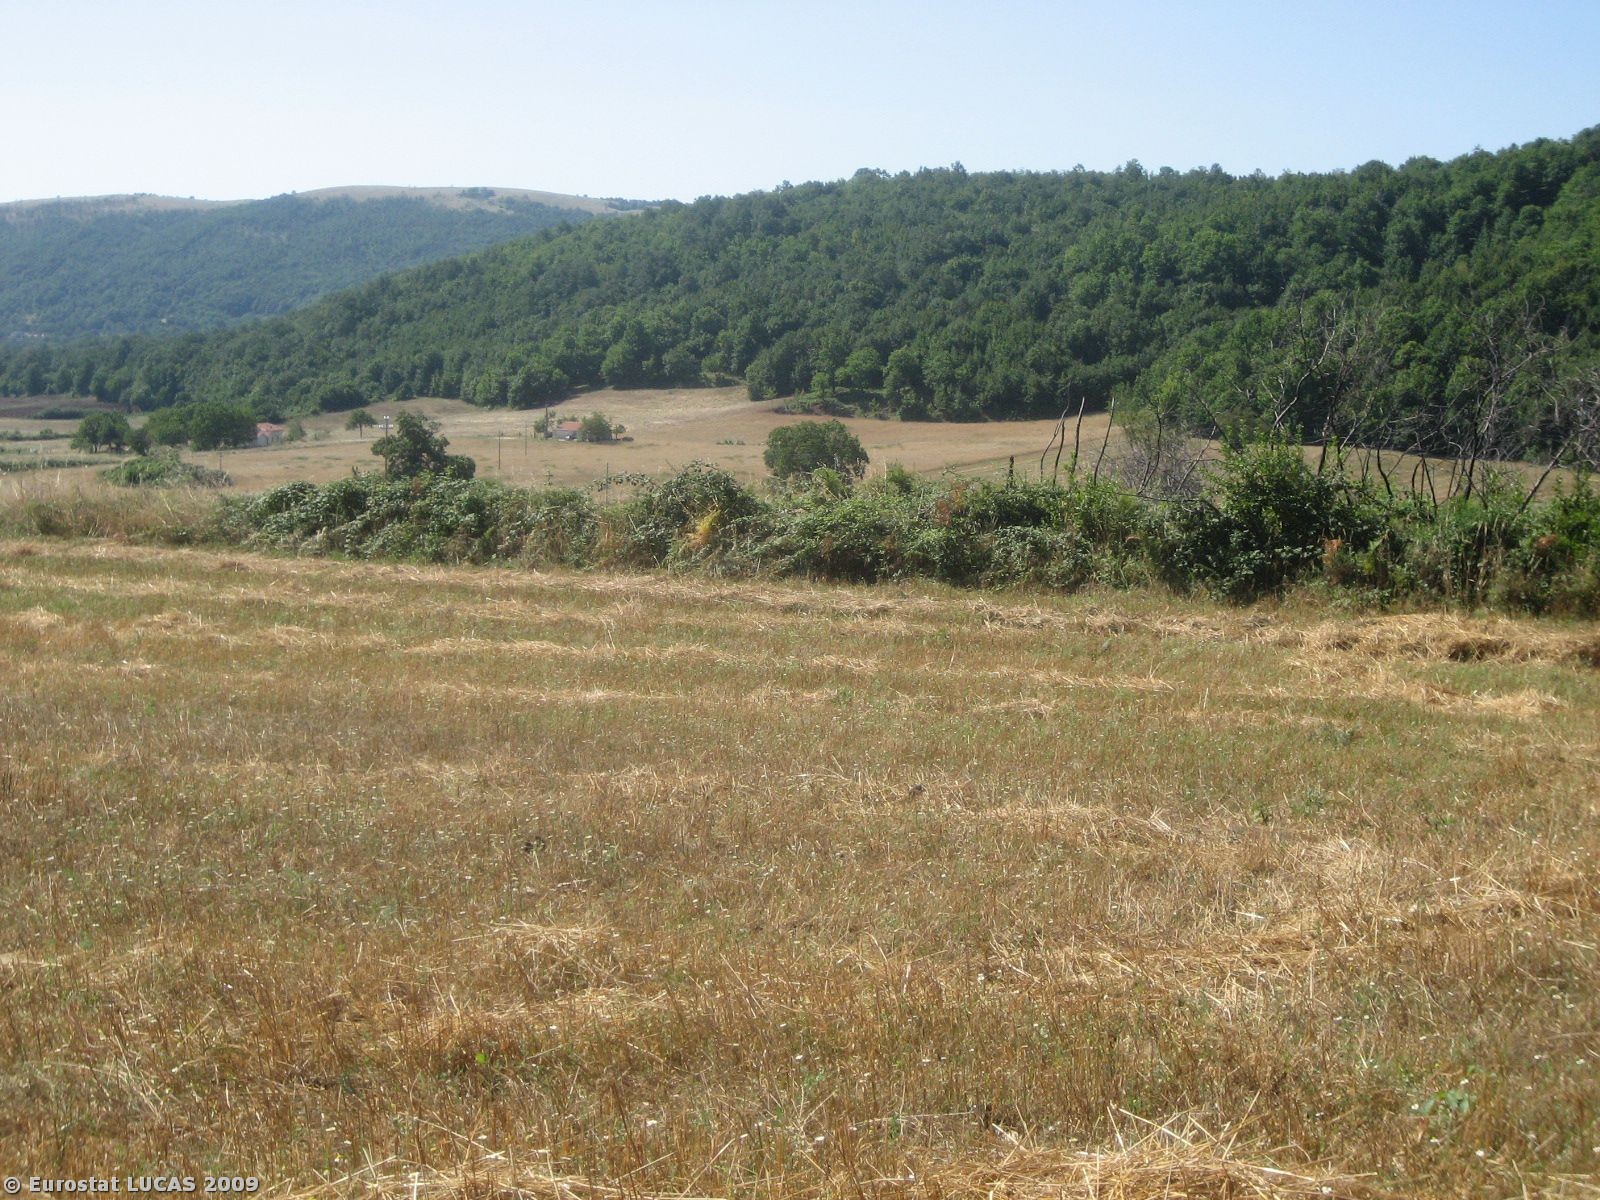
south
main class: Grassland
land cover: Grassland with sparse tree/shrub cover
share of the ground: > 75 %
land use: Agriculture (excluding fallow land and kitchen gardens)
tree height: > 5 m
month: July
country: IT
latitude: 41.7860
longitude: 15.7227
